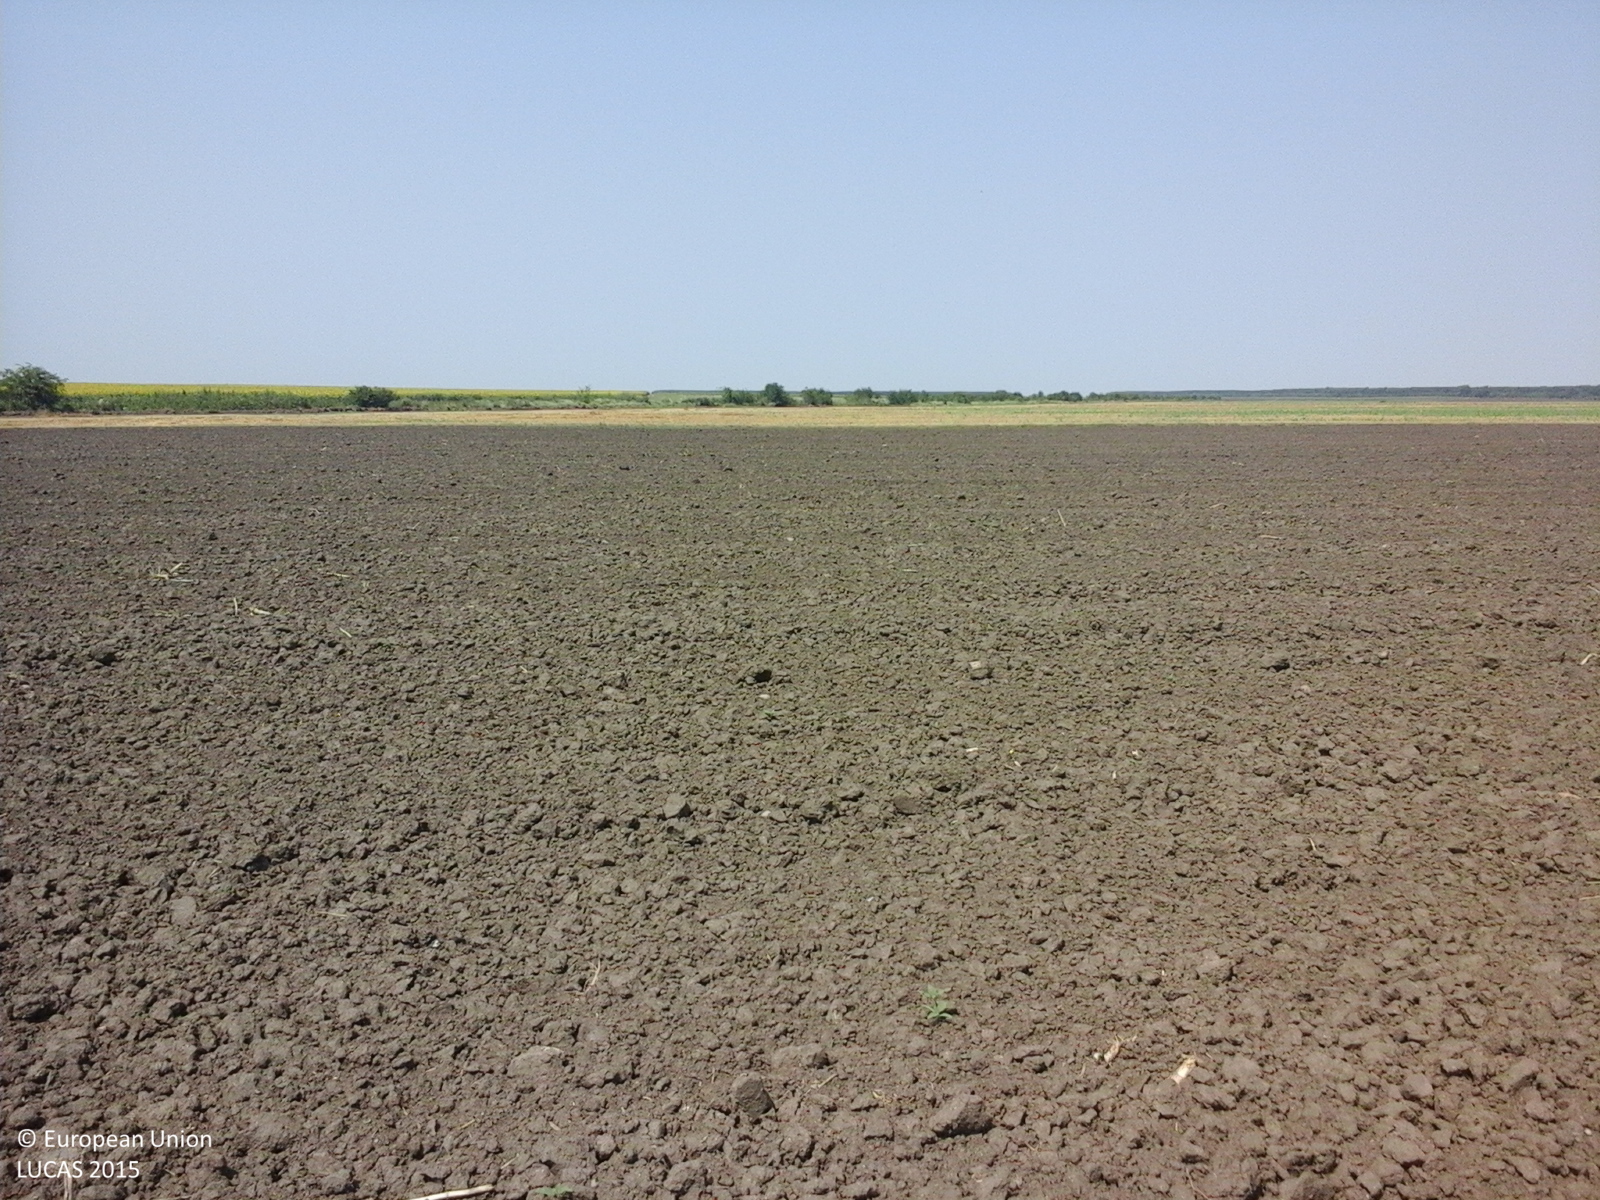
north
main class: Cropland
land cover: Common wheat
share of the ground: < 10 %
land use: Agriculture (excluding fallow land and kitchen gardens)
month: July
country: RO
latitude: 44.5716
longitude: 26.7836
